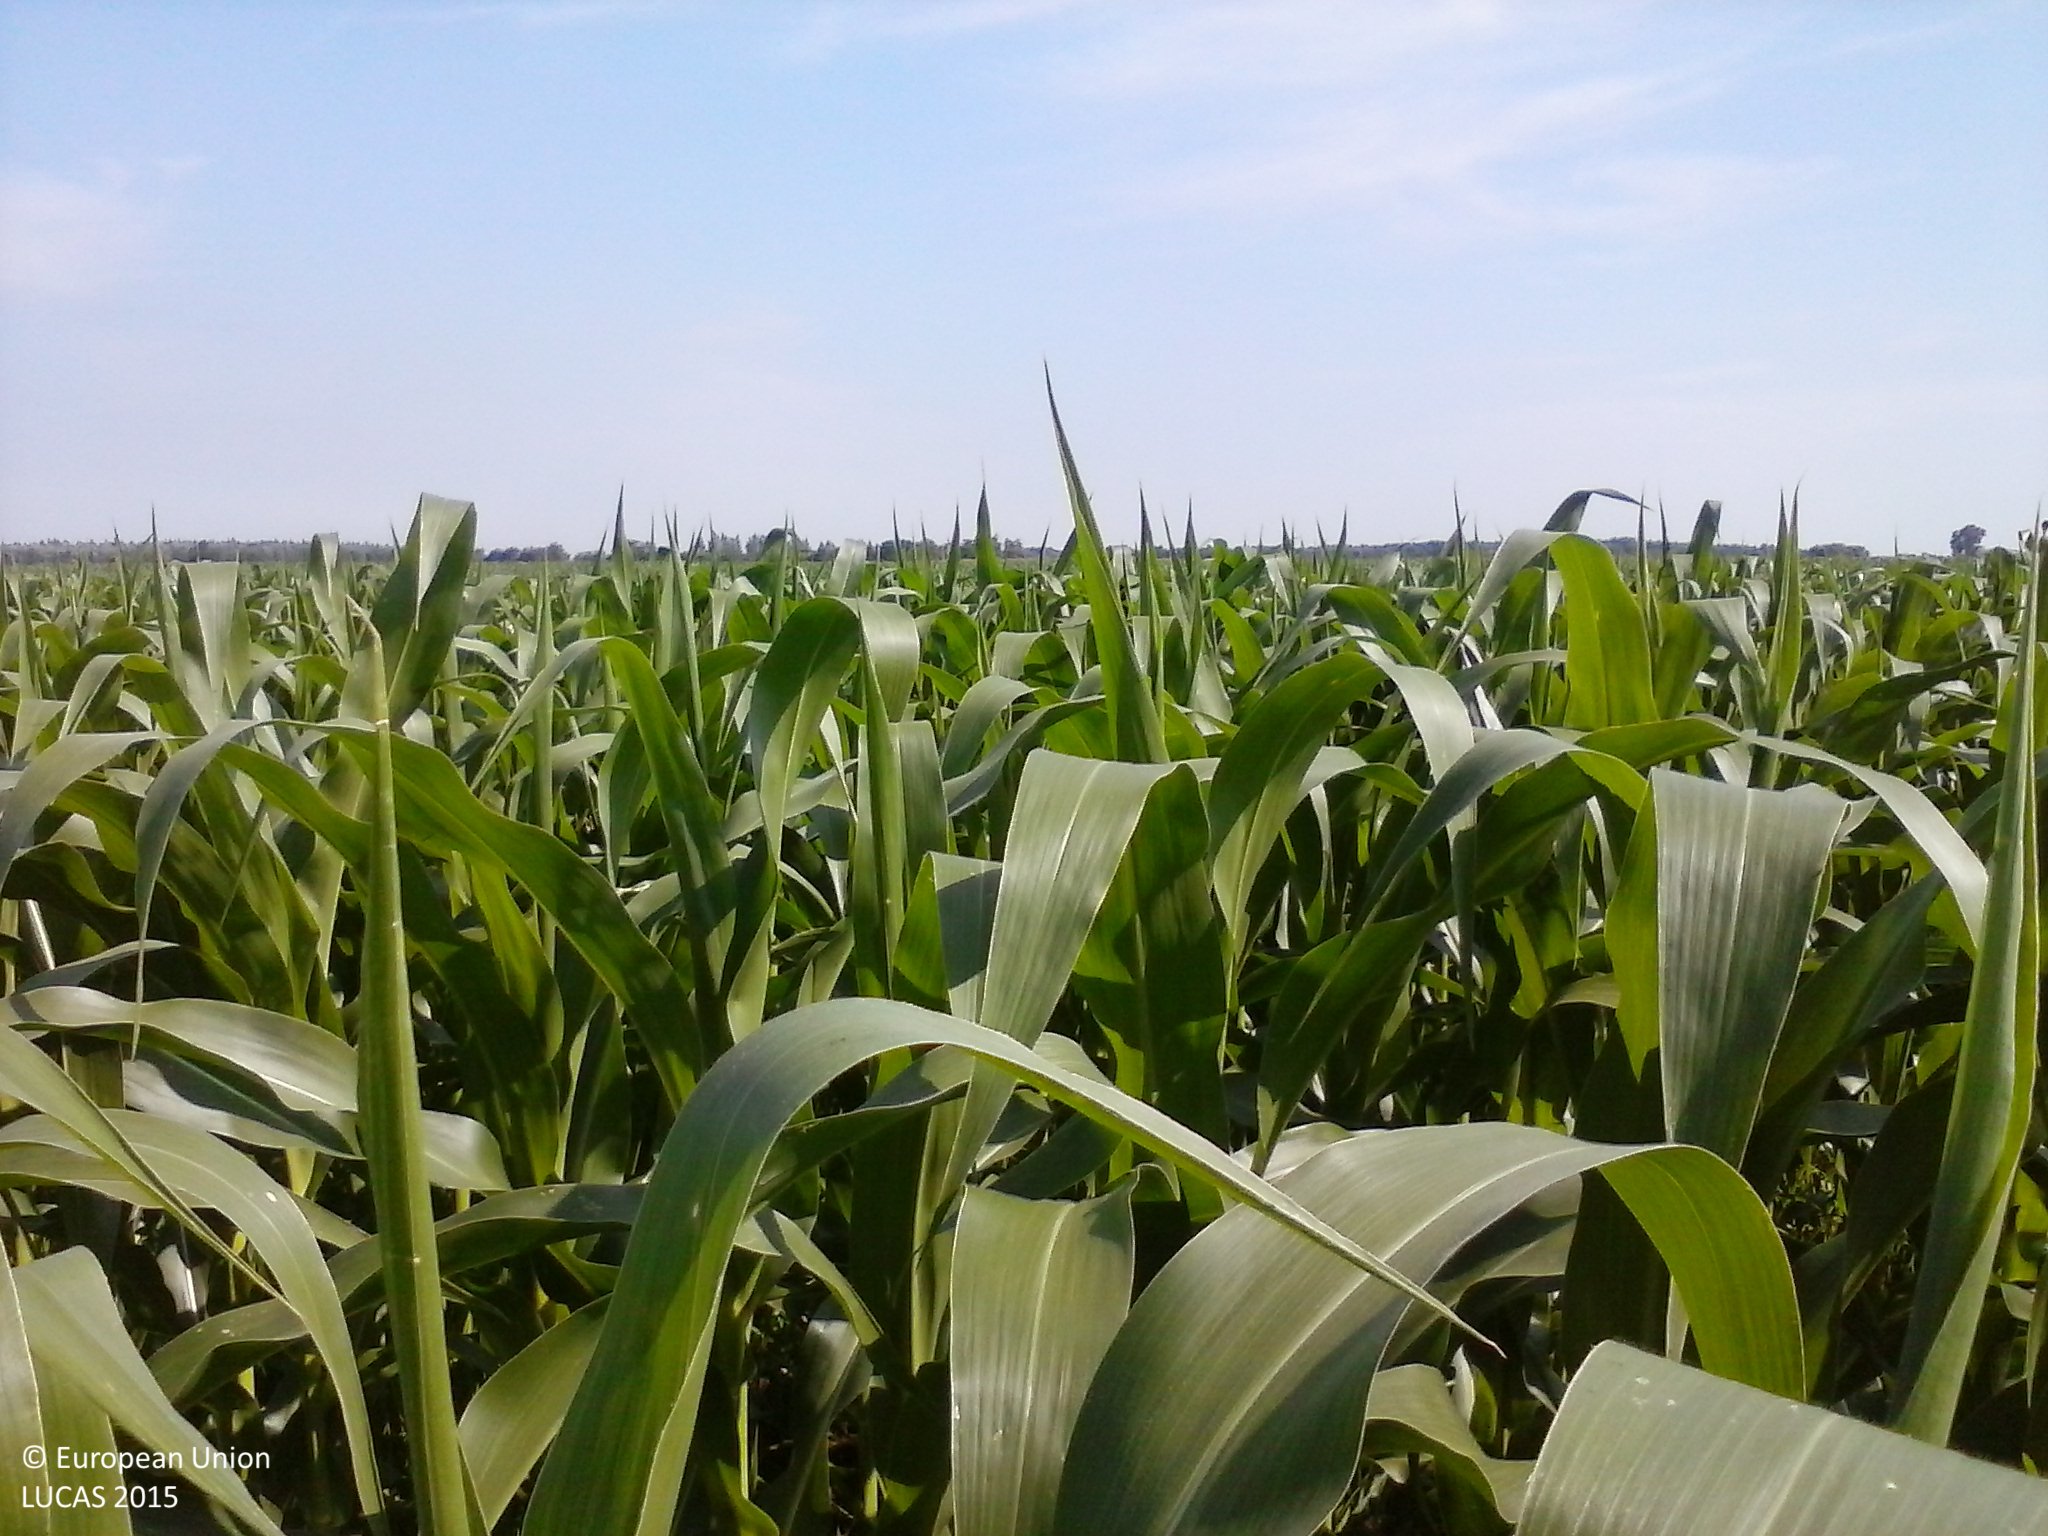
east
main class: Cropland
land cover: Maize
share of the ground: > 75 %
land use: Agriculture (excluding fallow land and kitchen gardens)
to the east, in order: Maize; Common wheat; Rye; Common wheat; Maize
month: June
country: HU
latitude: 46.1624
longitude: 19.5087
